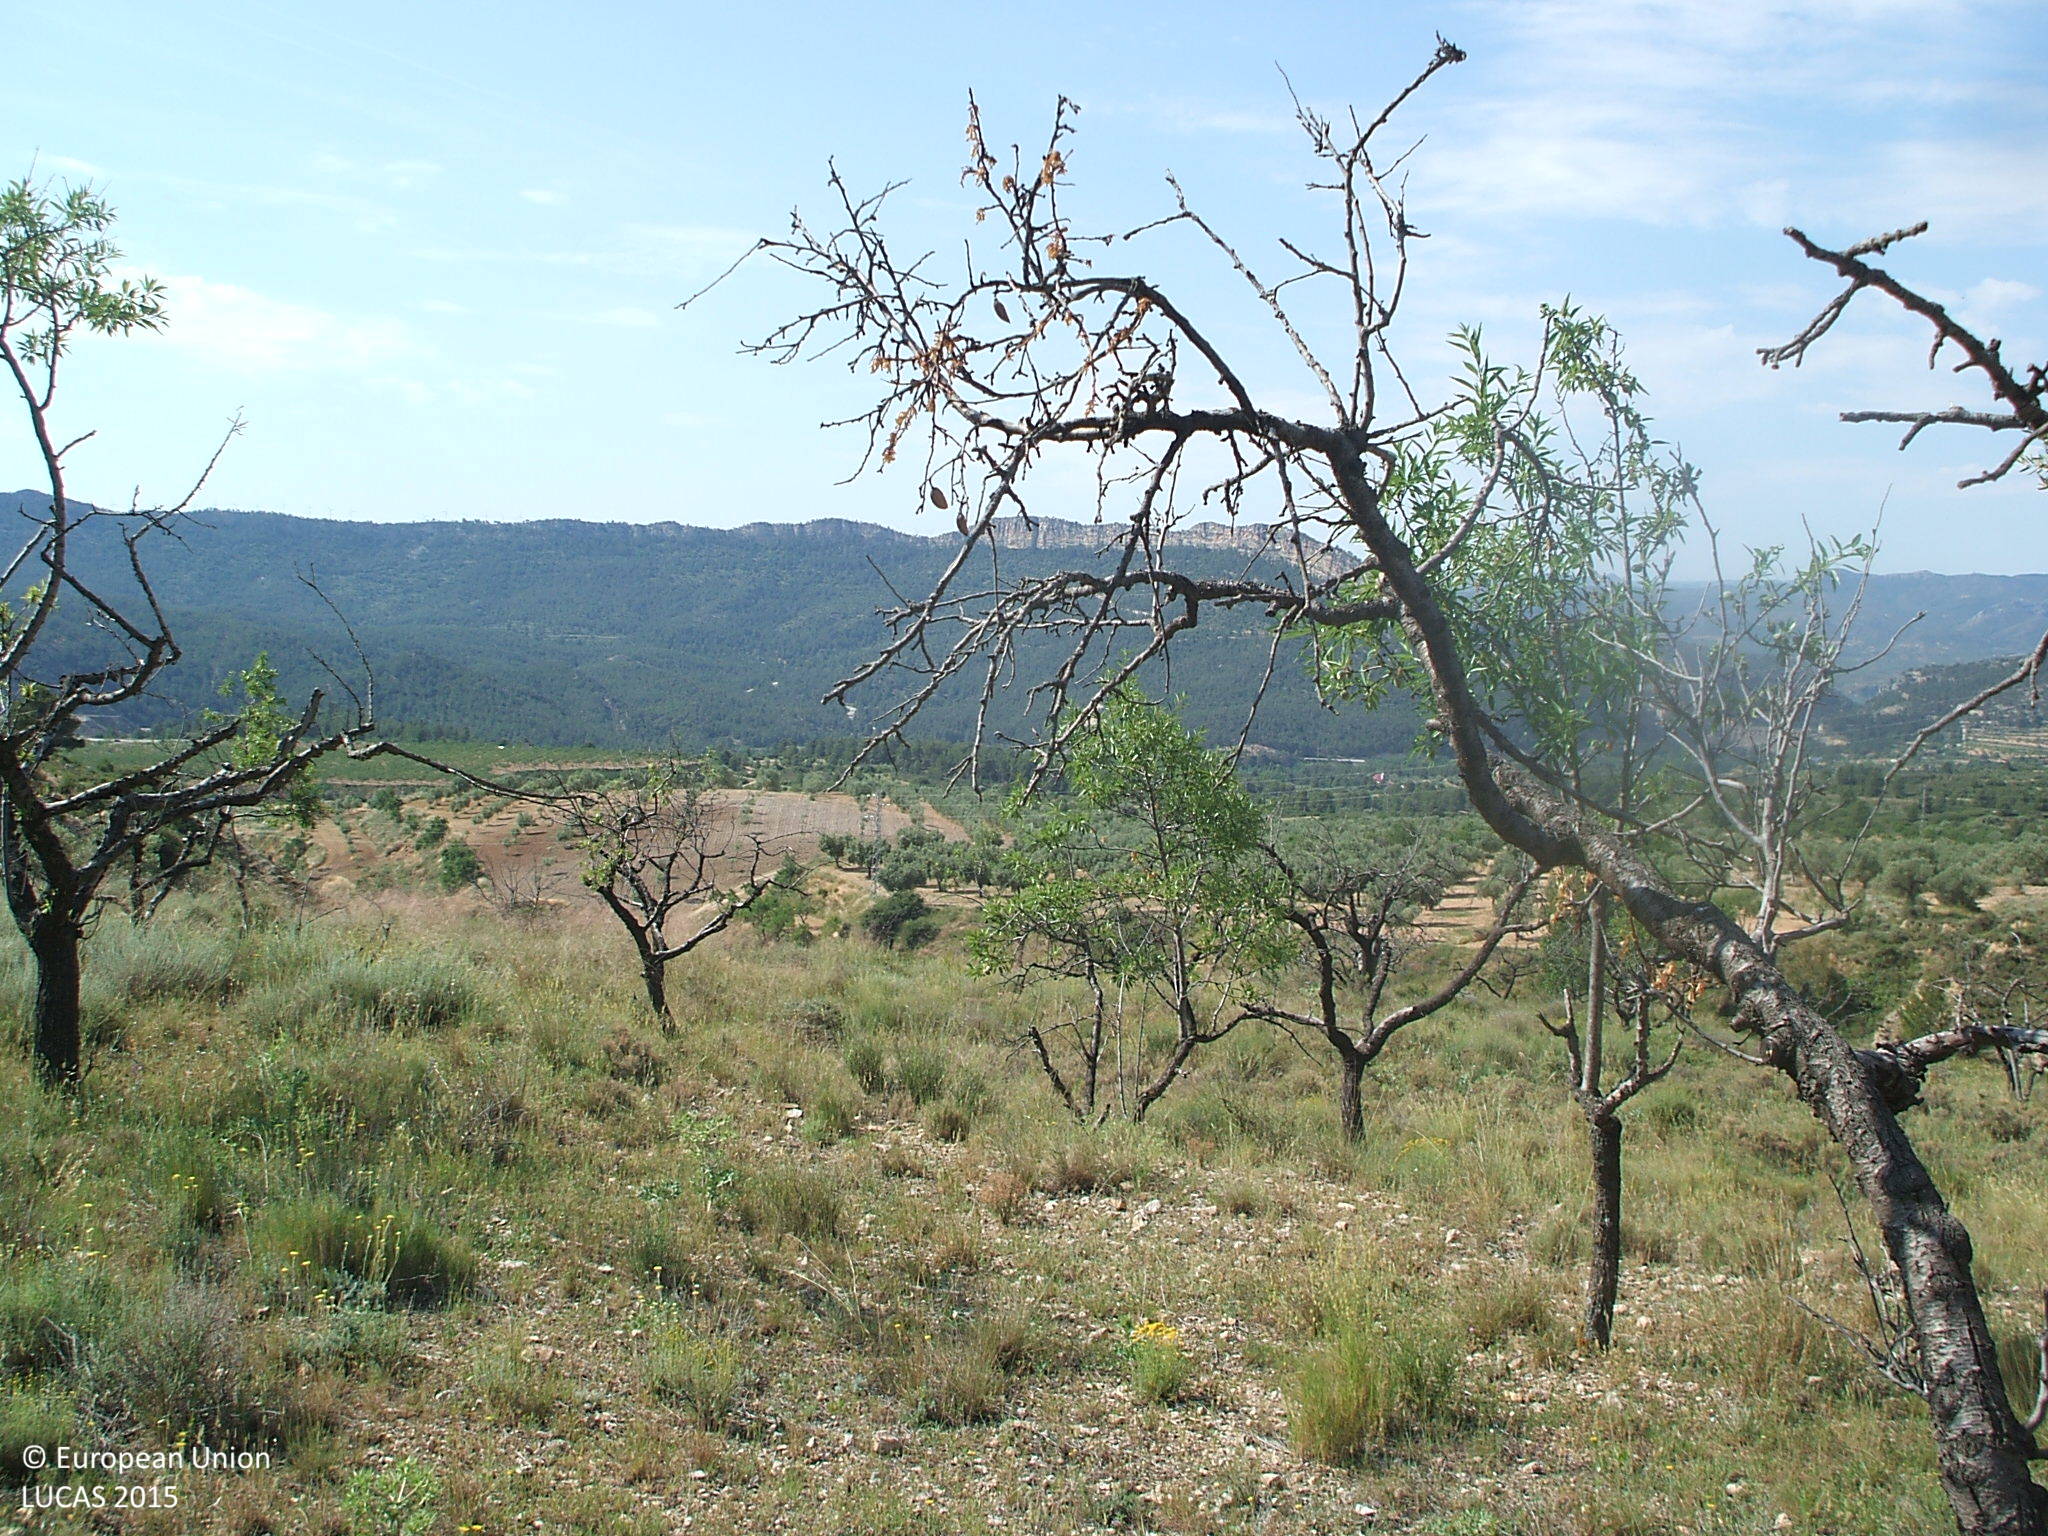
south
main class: Cropland
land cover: Nuts trees
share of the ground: 25 - 50 %
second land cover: Grassland without tree/shrub cover
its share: > 75 %
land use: Agriculture (excluding fallow land and kitchen gardens)
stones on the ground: > 50 %
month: June
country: ES
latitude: 40.7978
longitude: -0.3098
